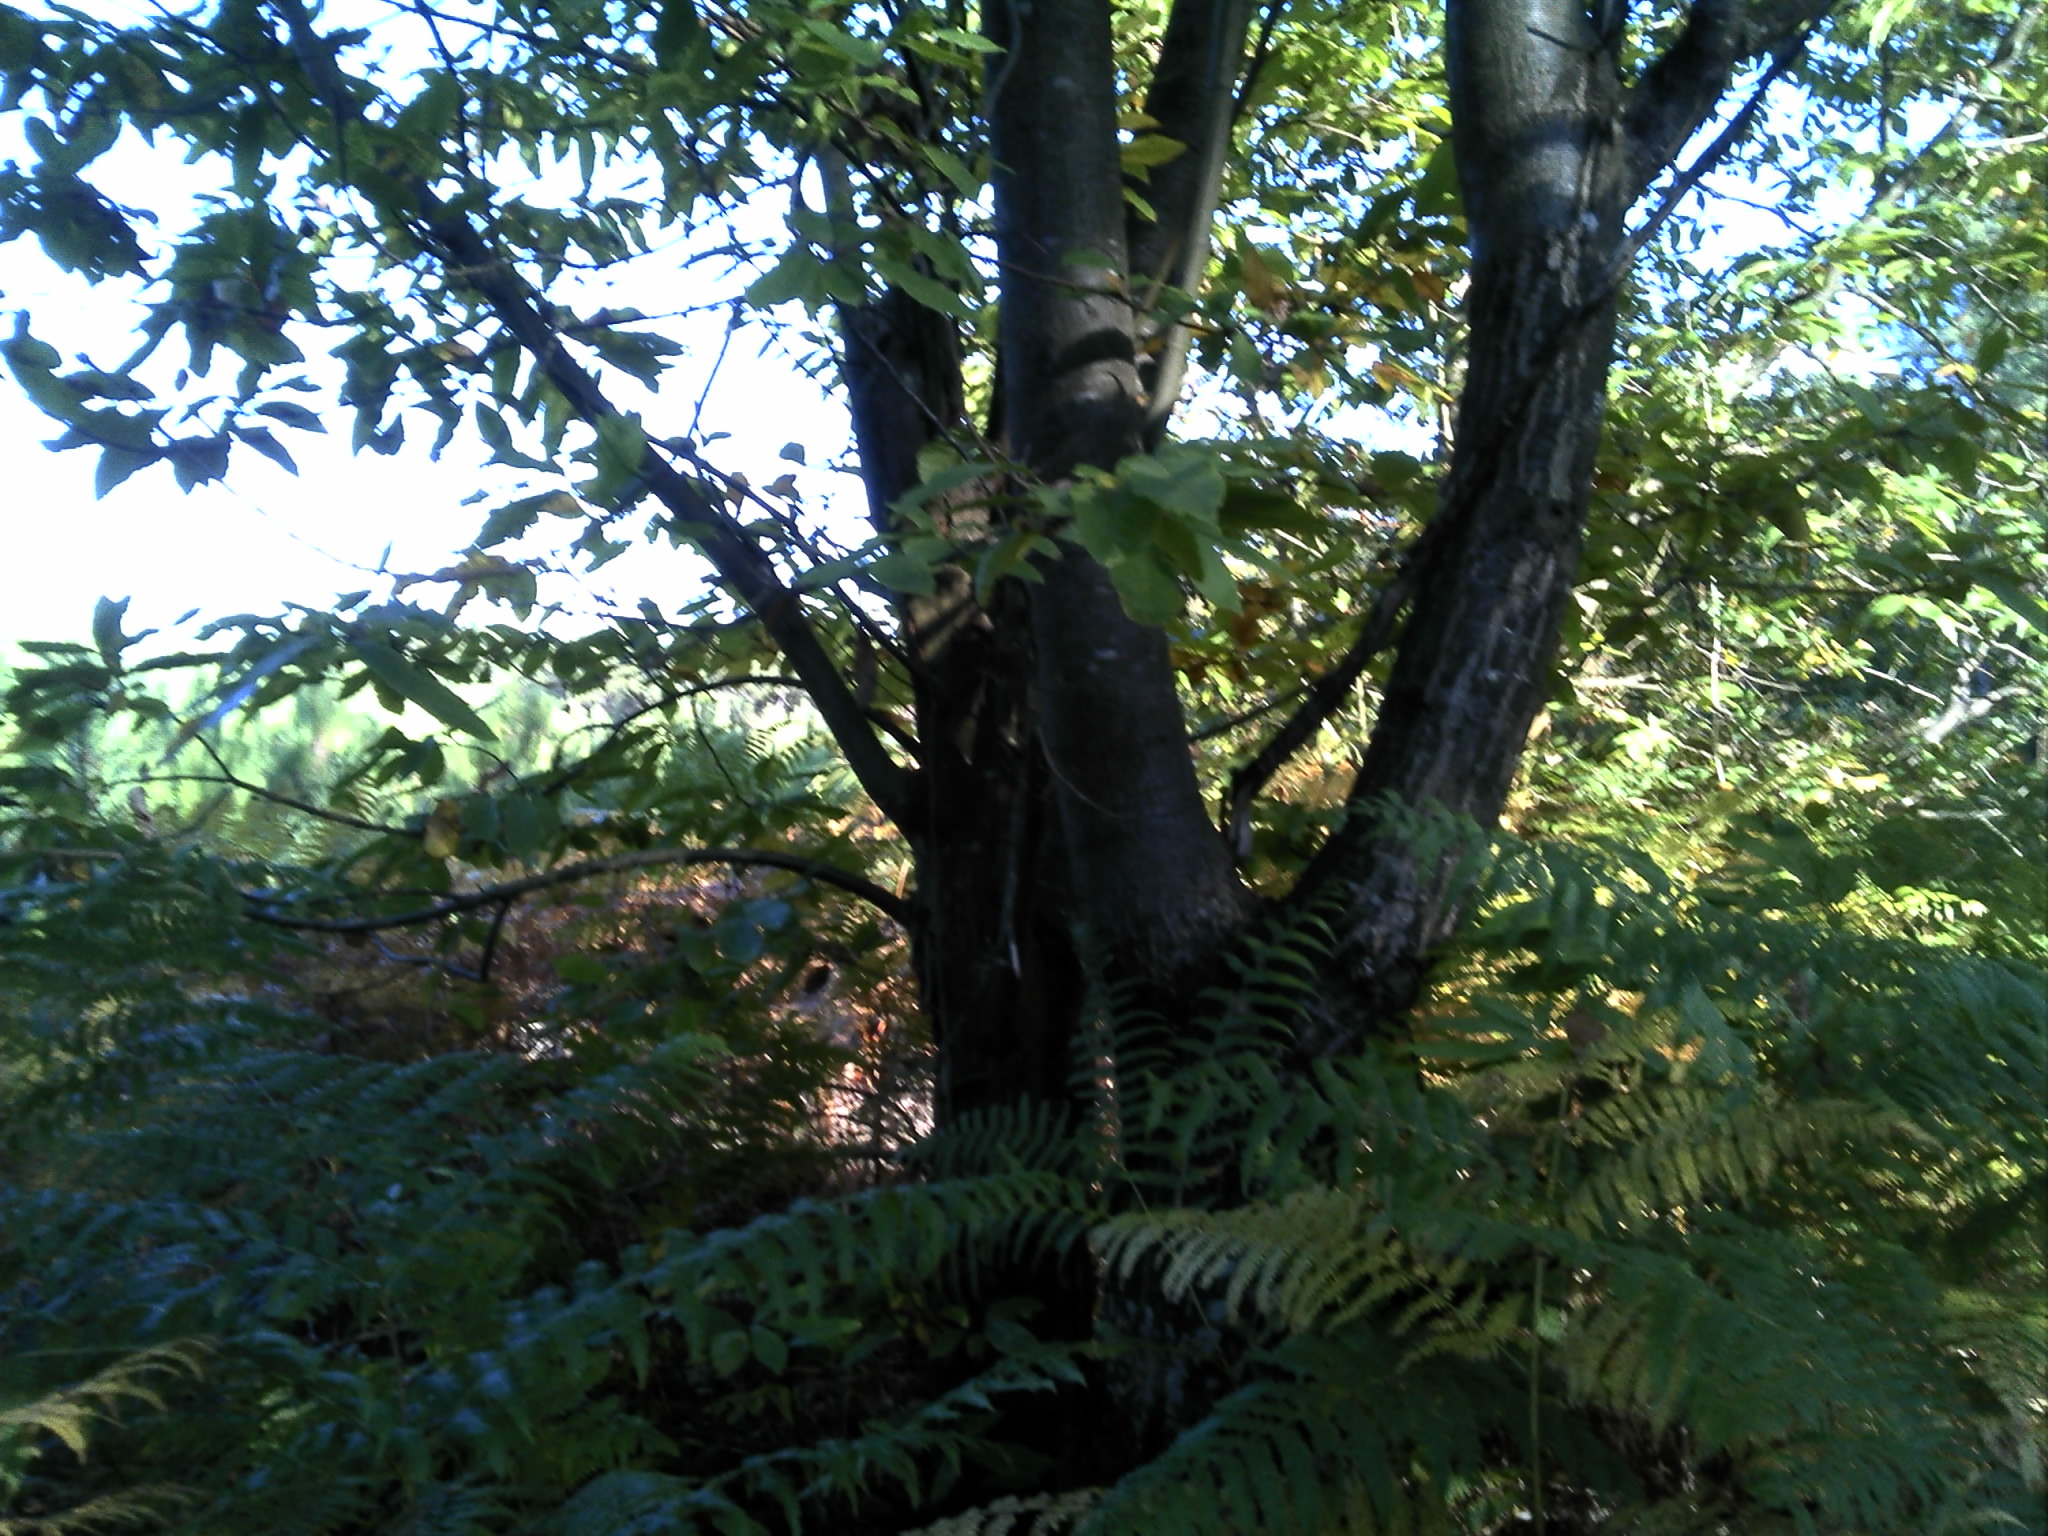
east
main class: Woodland
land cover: Pine dominated mixed woodland
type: hemiboreal forest and nemoral coniferous forest and mixed broadleaved-coniferous forest
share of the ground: > 75 %
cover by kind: coniferous forest trees 75 %, broadleaved forest trees 25 %
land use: Forestry
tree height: > 5 m
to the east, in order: Pine dominated mixed woodland; Pine dominated coniferous woodland
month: September
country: FR
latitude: 47.7969
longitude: 0.3235
